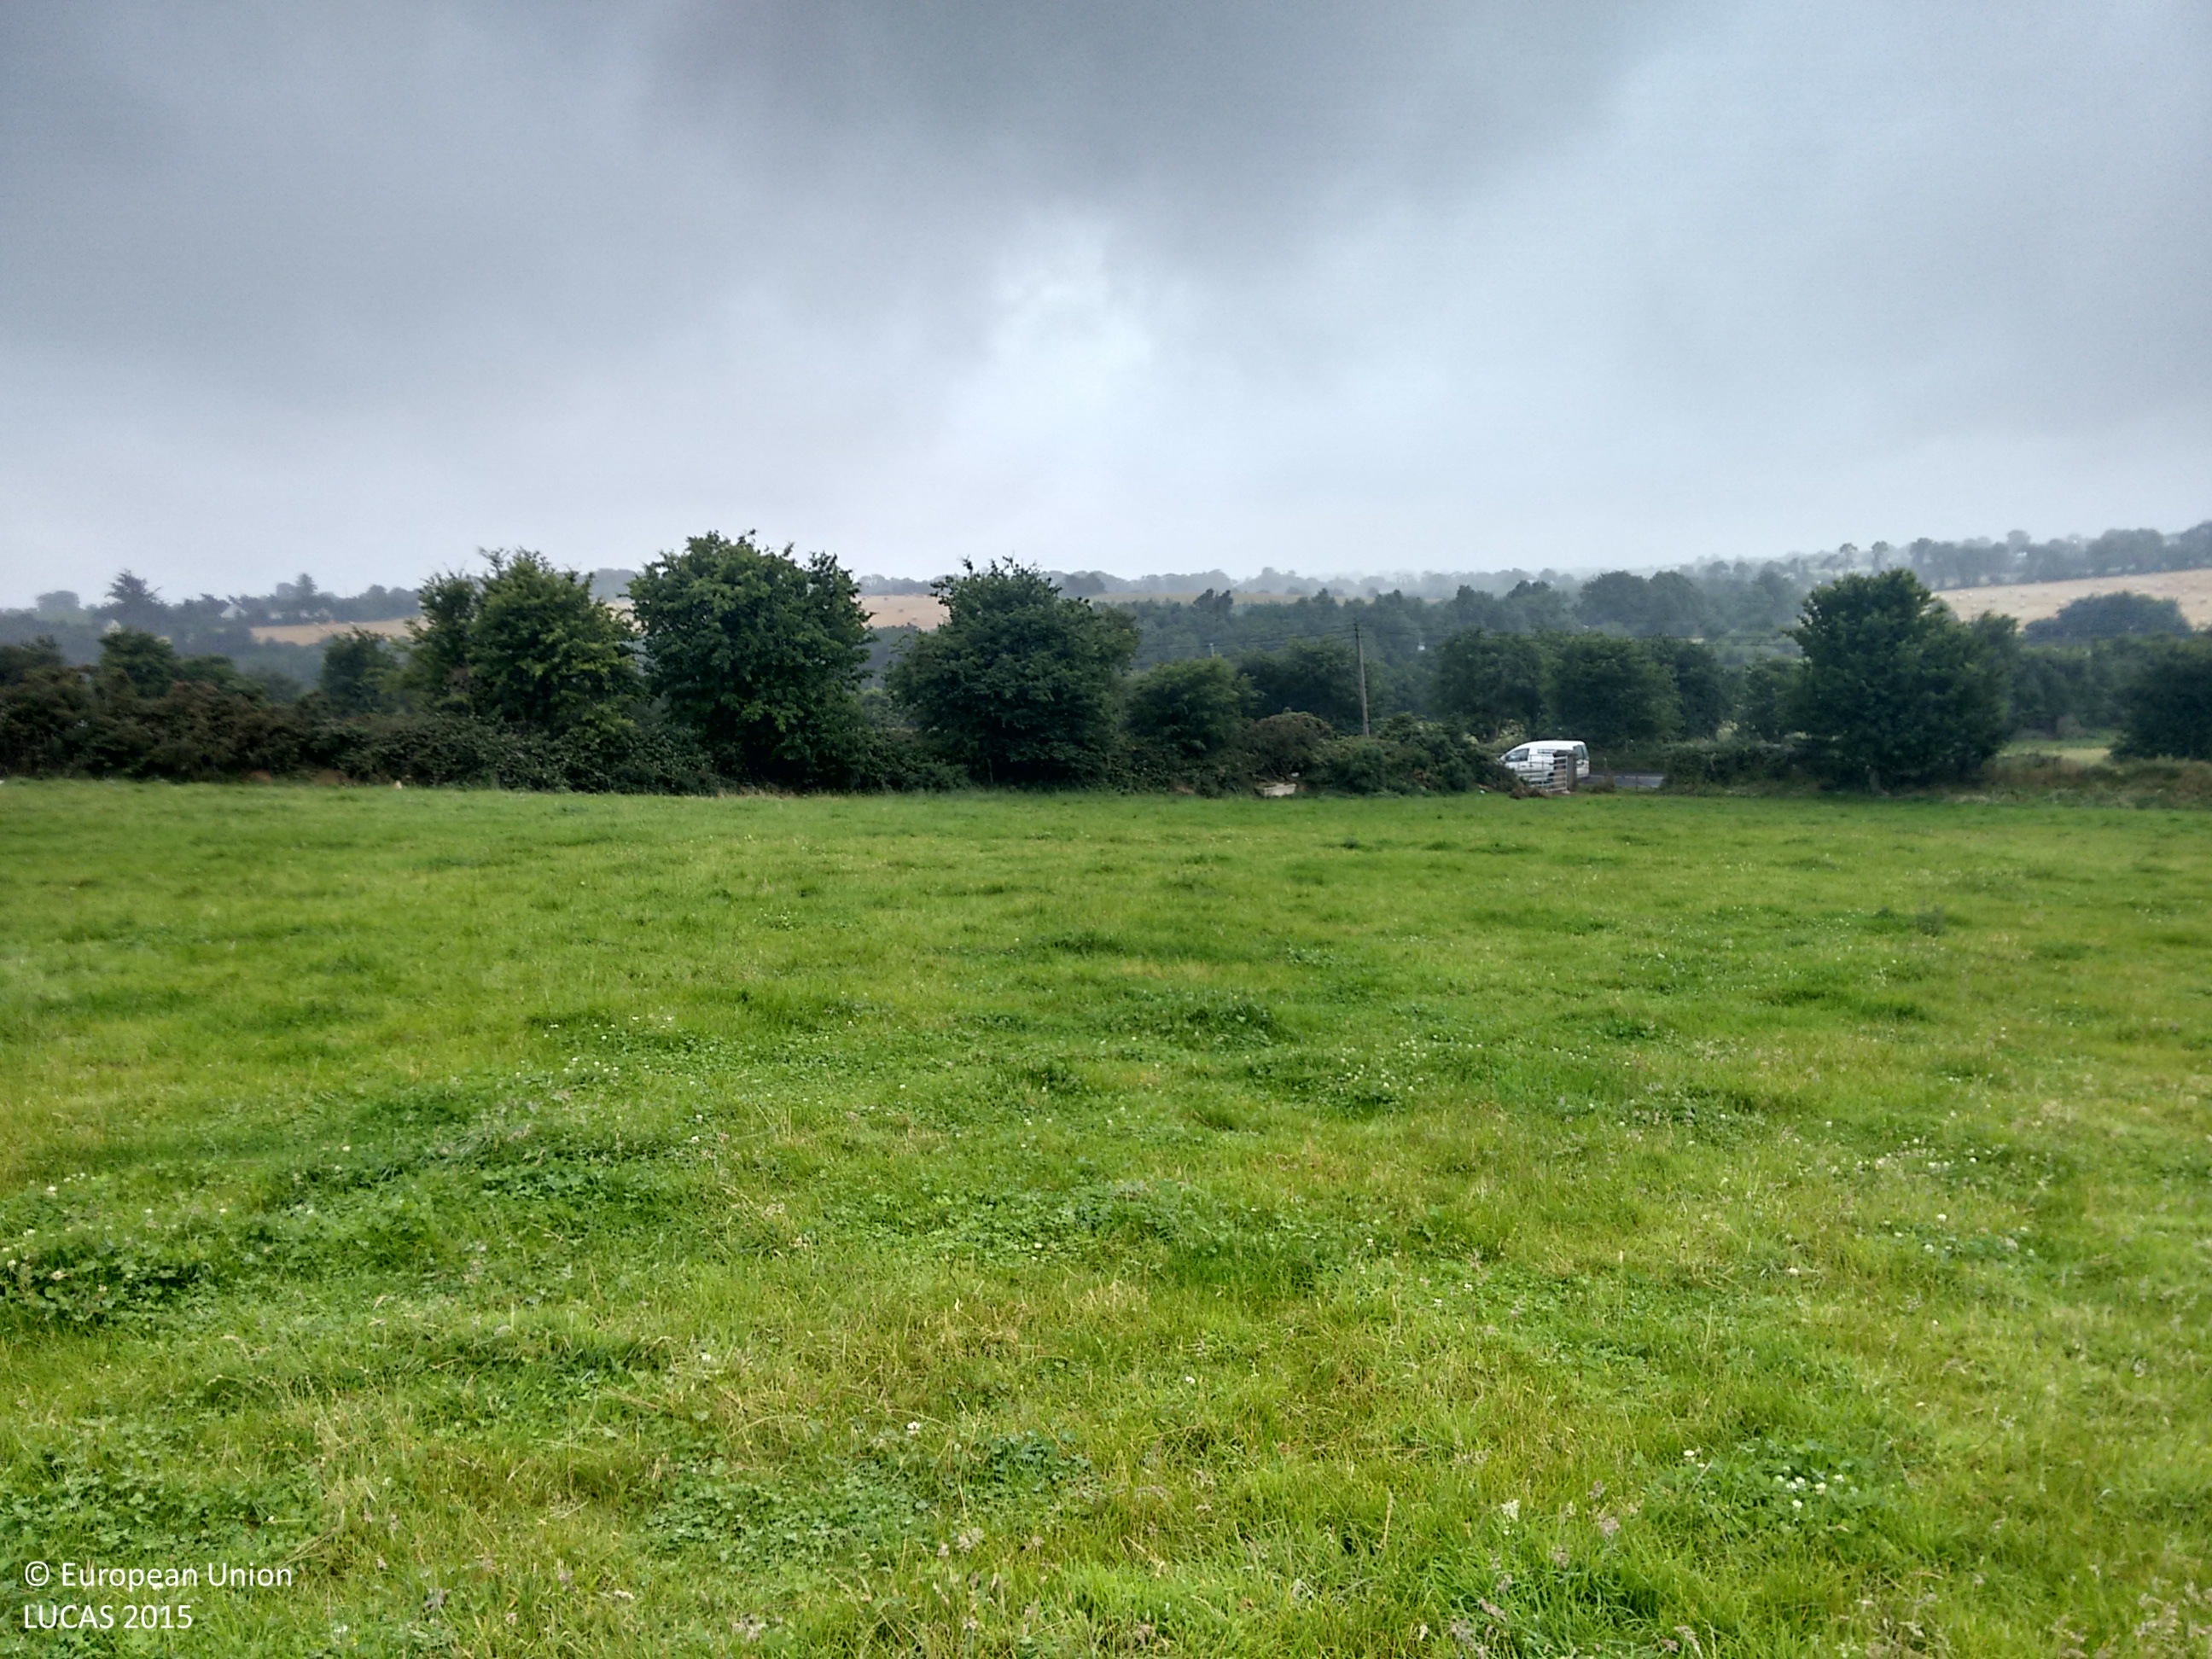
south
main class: Grassland
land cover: Grassland without tree/shrub cover
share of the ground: > 75 %
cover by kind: herbaceous plants 100 %
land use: Agriculture (excluding fallow land and kitchen gardens)
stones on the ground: < 10 %
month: August
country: IE
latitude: 52.6795
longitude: -6.3796
